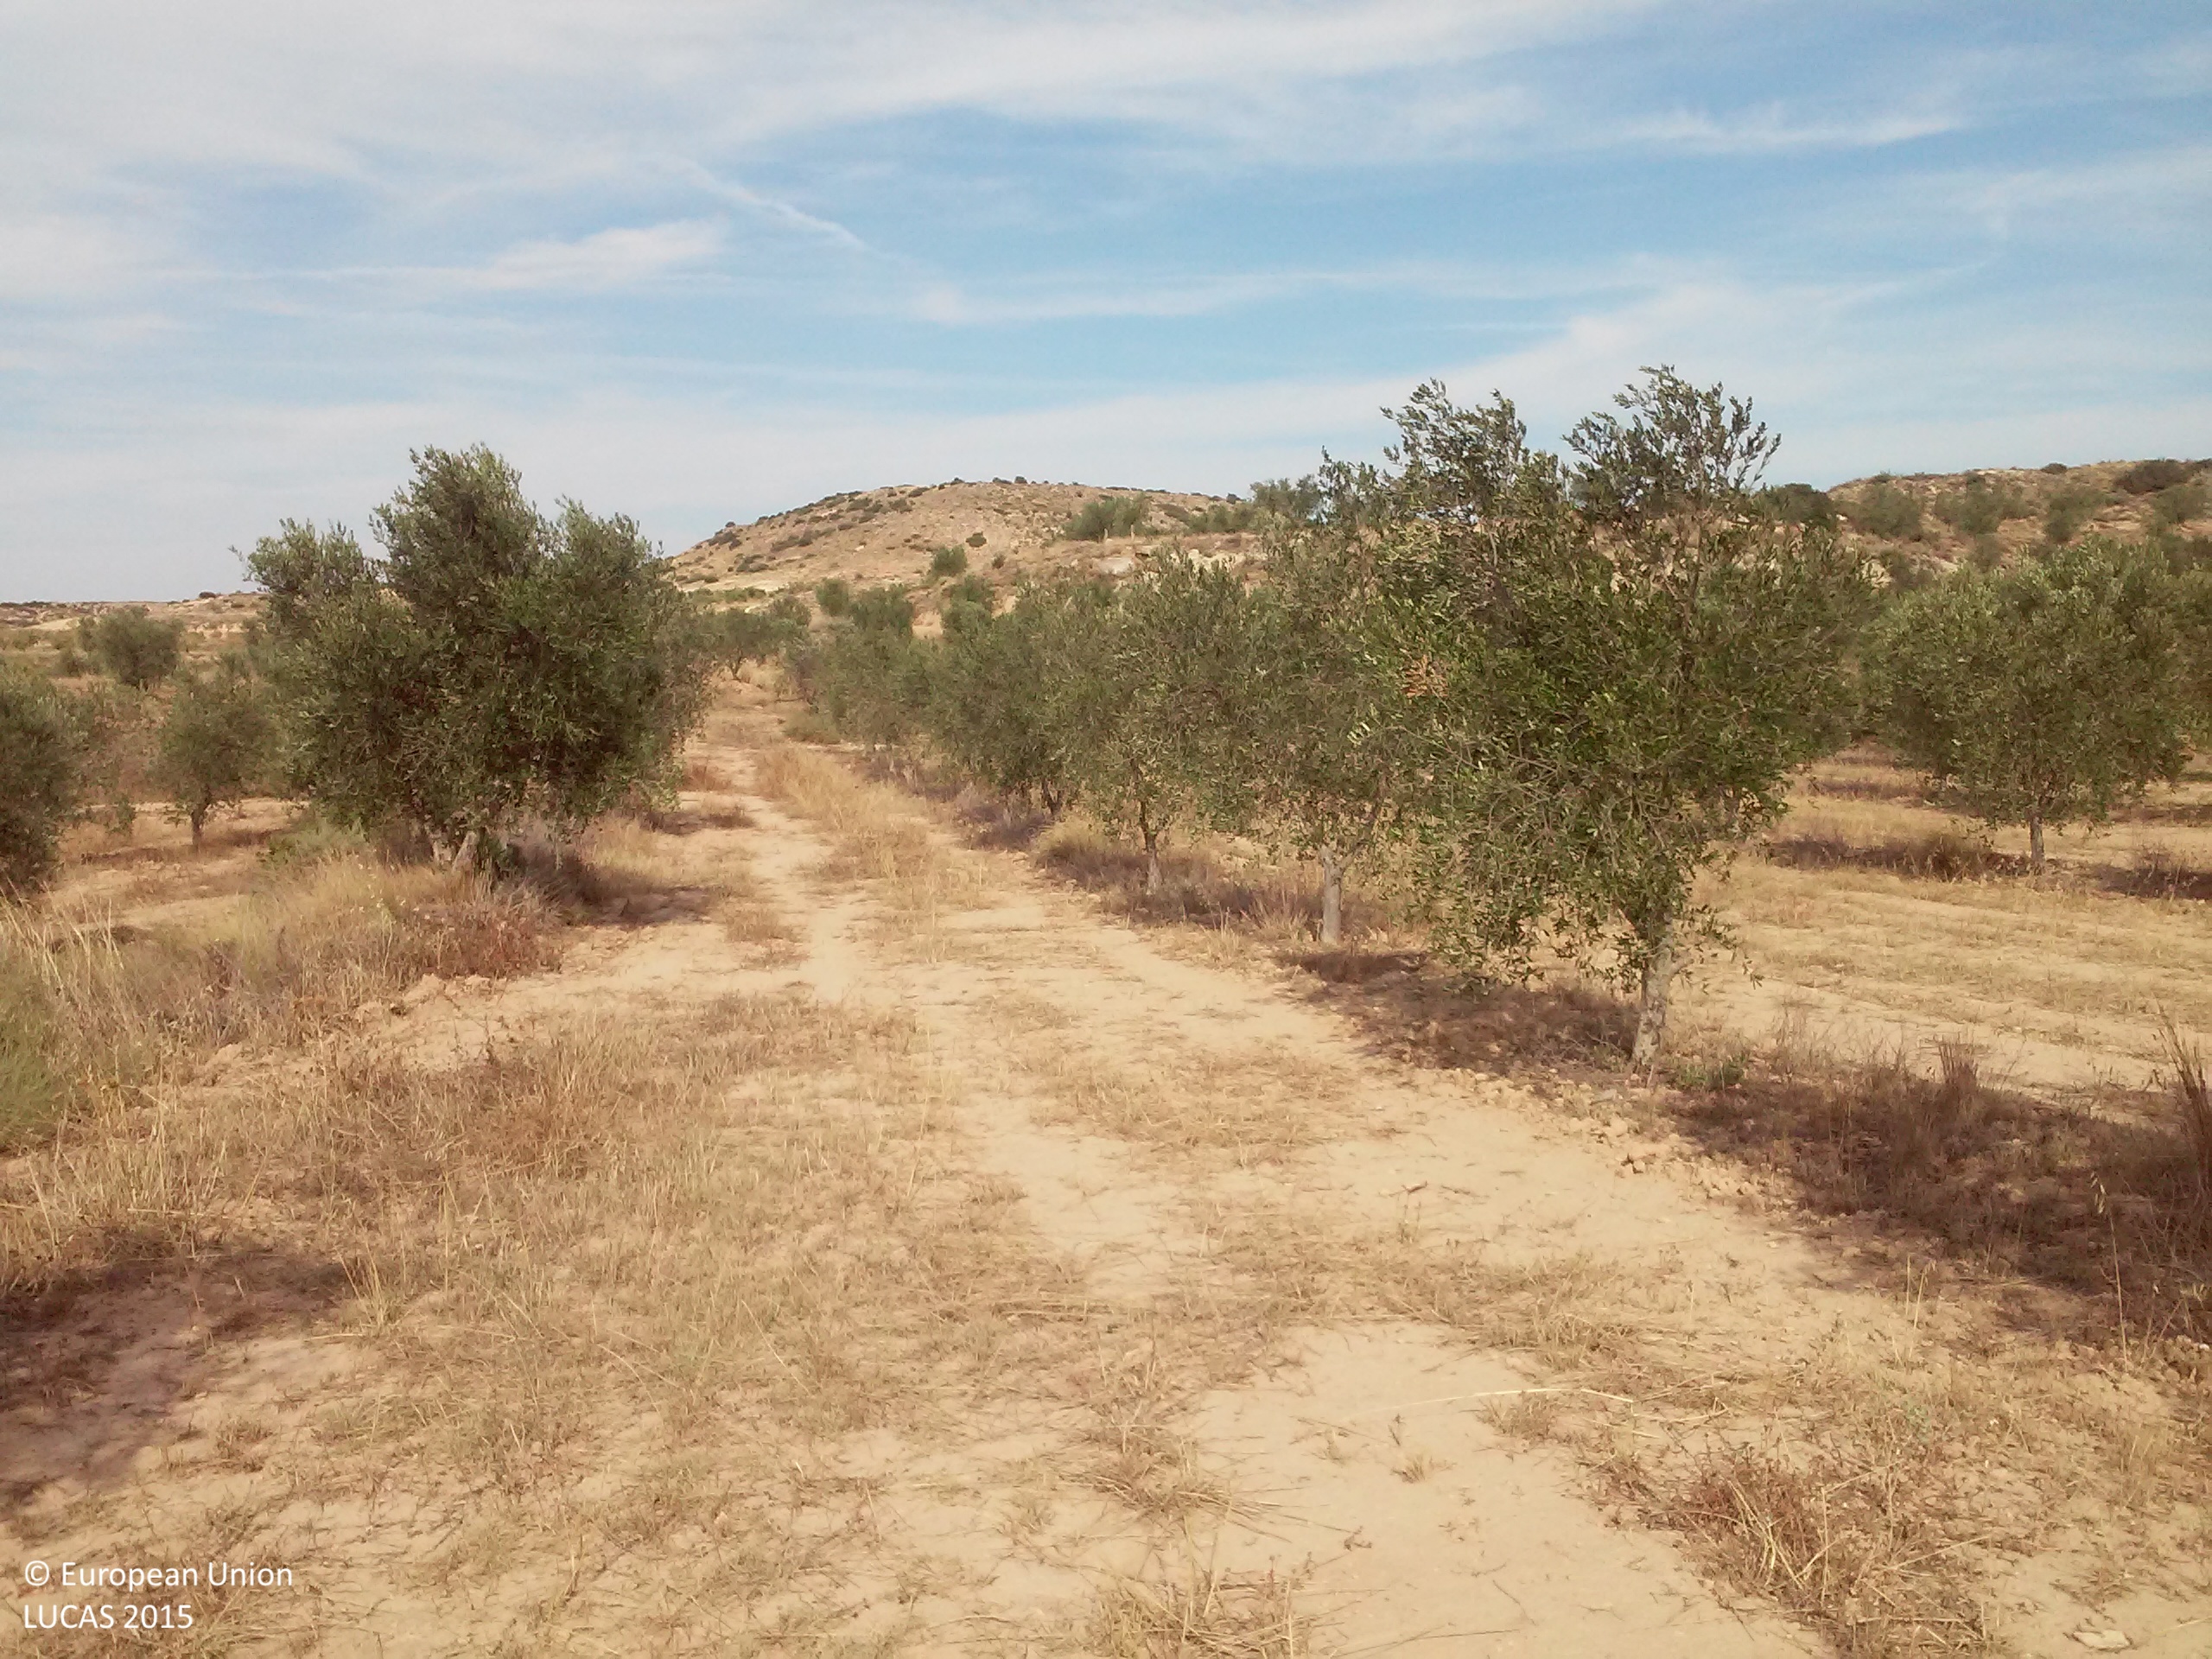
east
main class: Cropland
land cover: Olive groves
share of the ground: 10 - 25 %
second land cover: Other bare soil
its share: > 75 %
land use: Agriculture (excluding fallow land and kitchen gardens)
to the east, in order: Olive groves; Other bare soil; Shruby margins; Olive groves; Shruby margins; Olive groves; Shrubland with sparse tree cover; Olive groves; Shrubland with sparse tree cover; Nuts trees
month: August
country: ES
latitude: 41.4428
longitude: 0.4971
